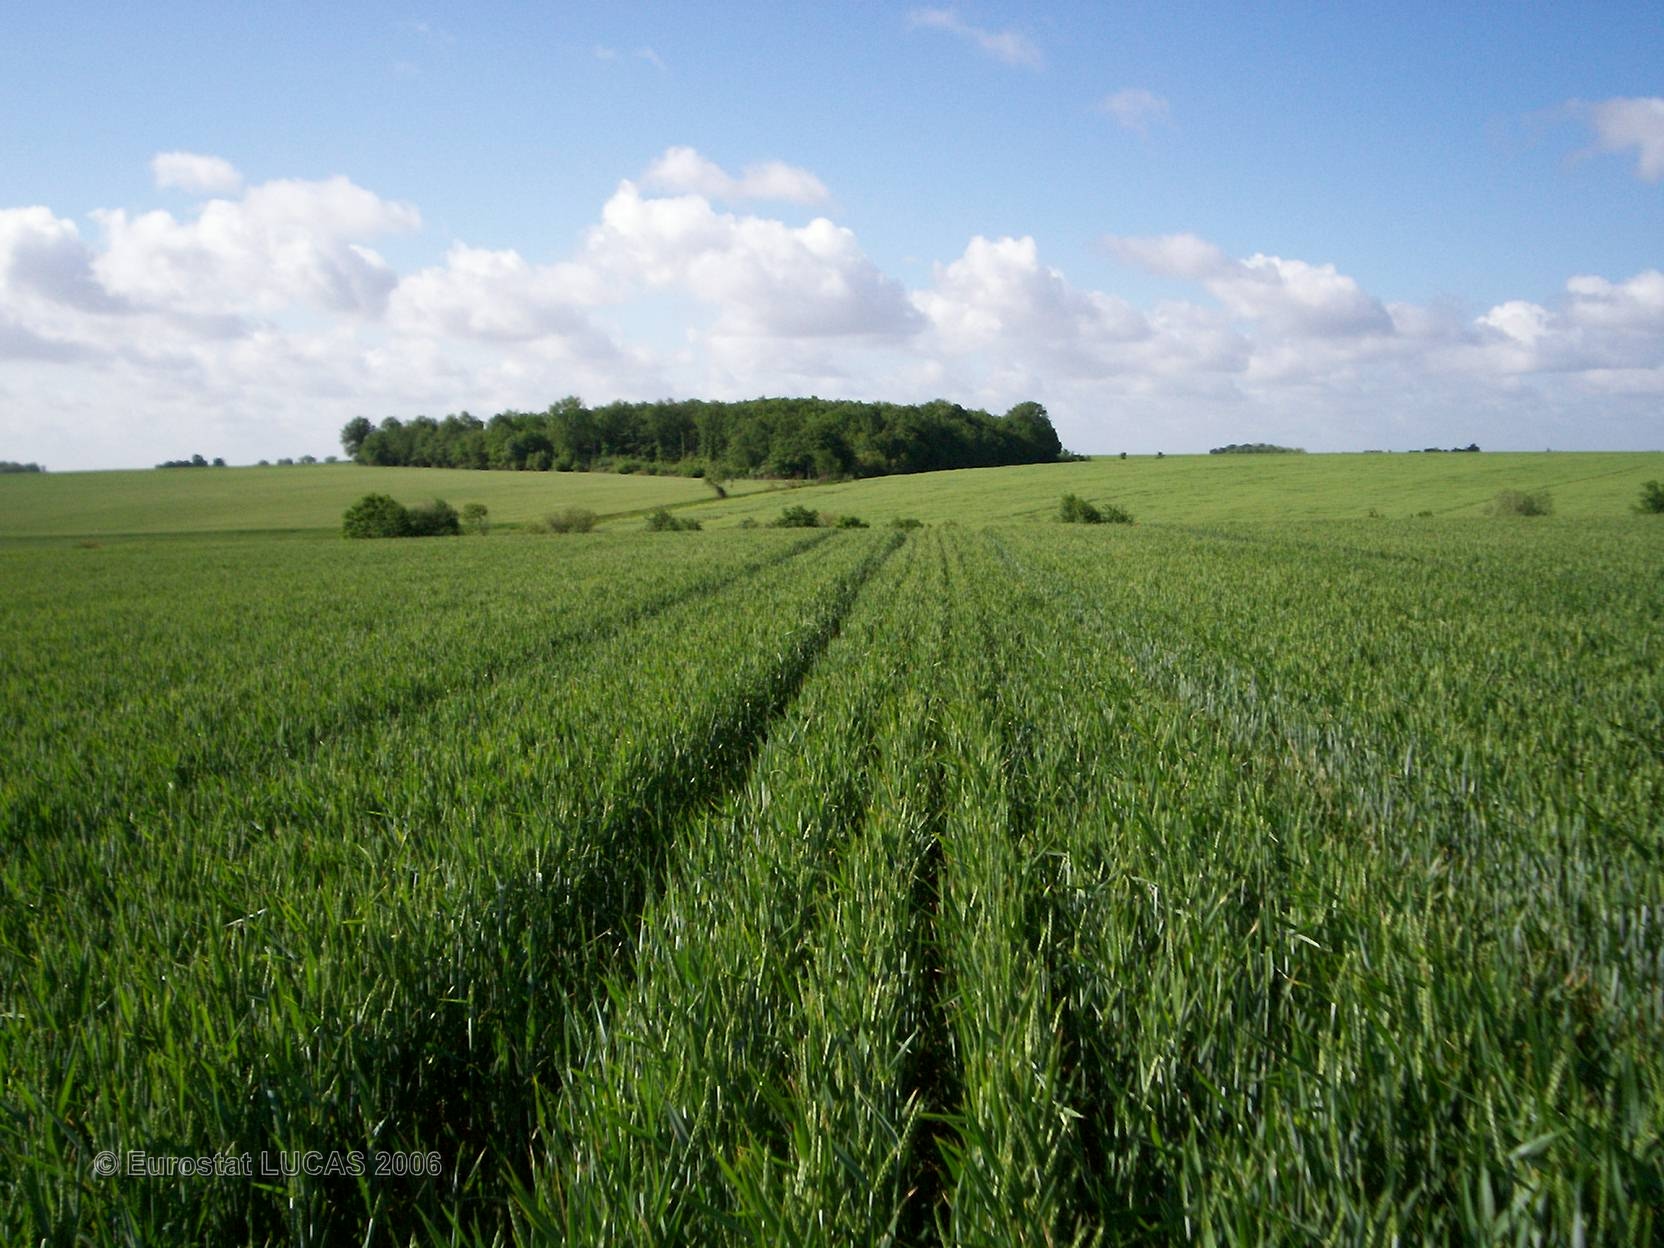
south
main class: Cropland
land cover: Common wheat
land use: Agriculture (excluding fallow land and kitchen gardens)
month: May
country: FR
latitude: 47.5171
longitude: 0.8584
